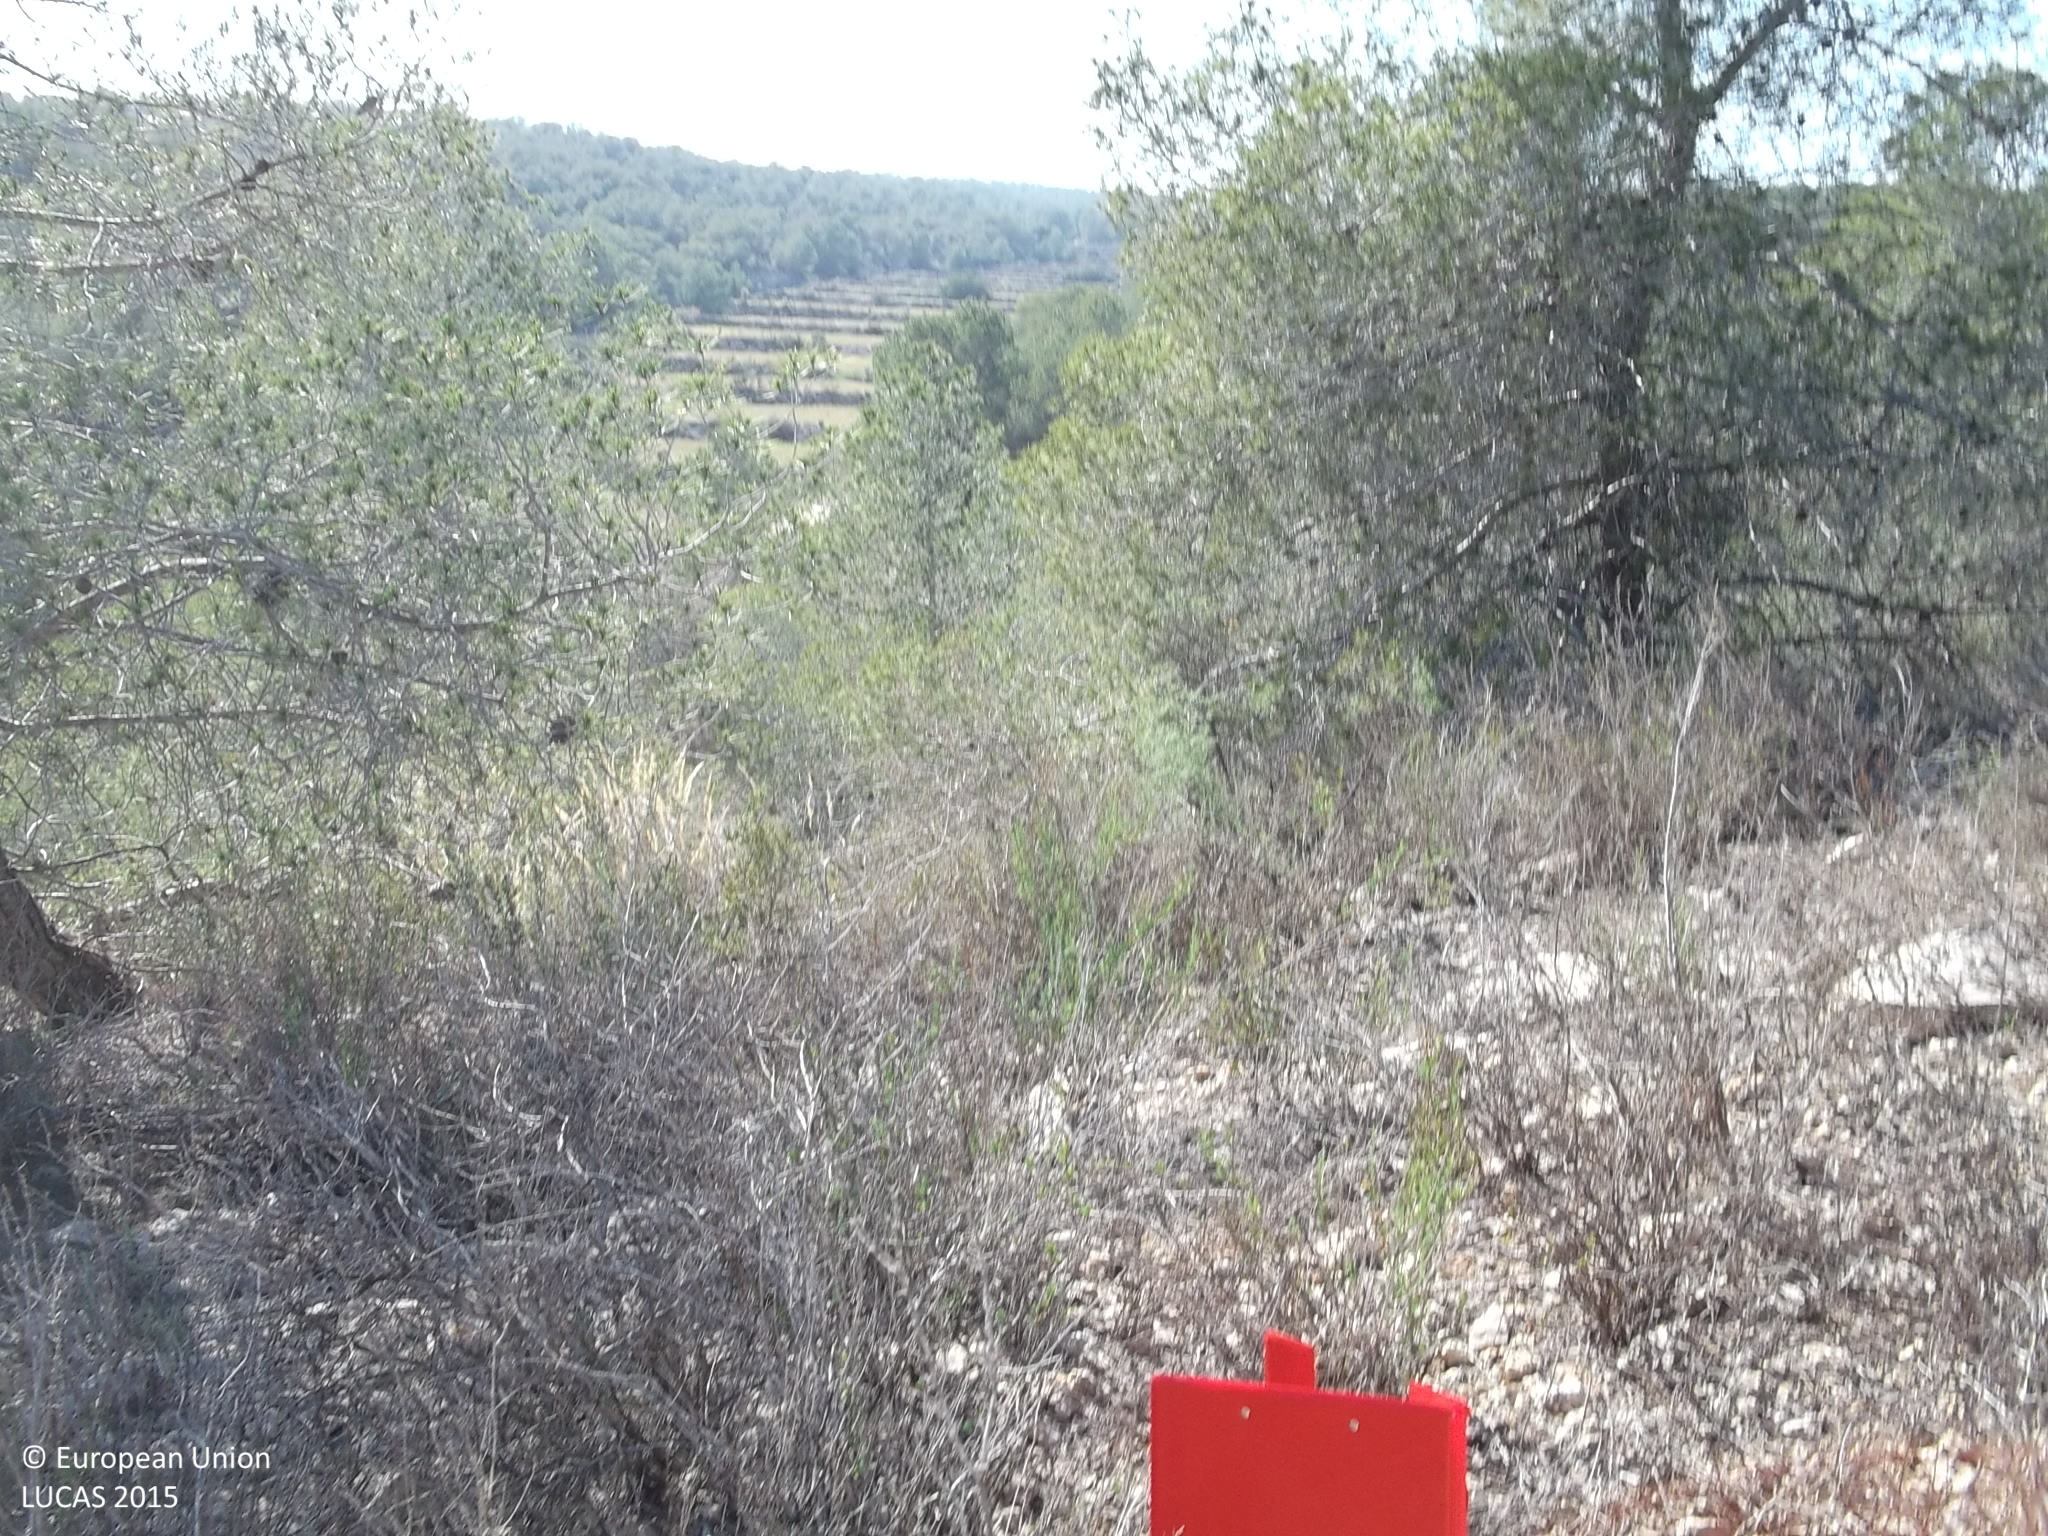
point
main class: Woodland
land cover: Pine dominated coniferous woodland
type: coniferous forest of the mediterranean region
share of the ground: 10 - 25 %
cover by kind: shrubs 30 %, consolidated bare surface 30 %, coniferous forest trees 20 %, herbaceous plants 20 %
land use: Semi-natural and natural areas not in use
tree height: > 5 m
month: May
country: ES
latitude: 37.9500
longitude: -0.8275
